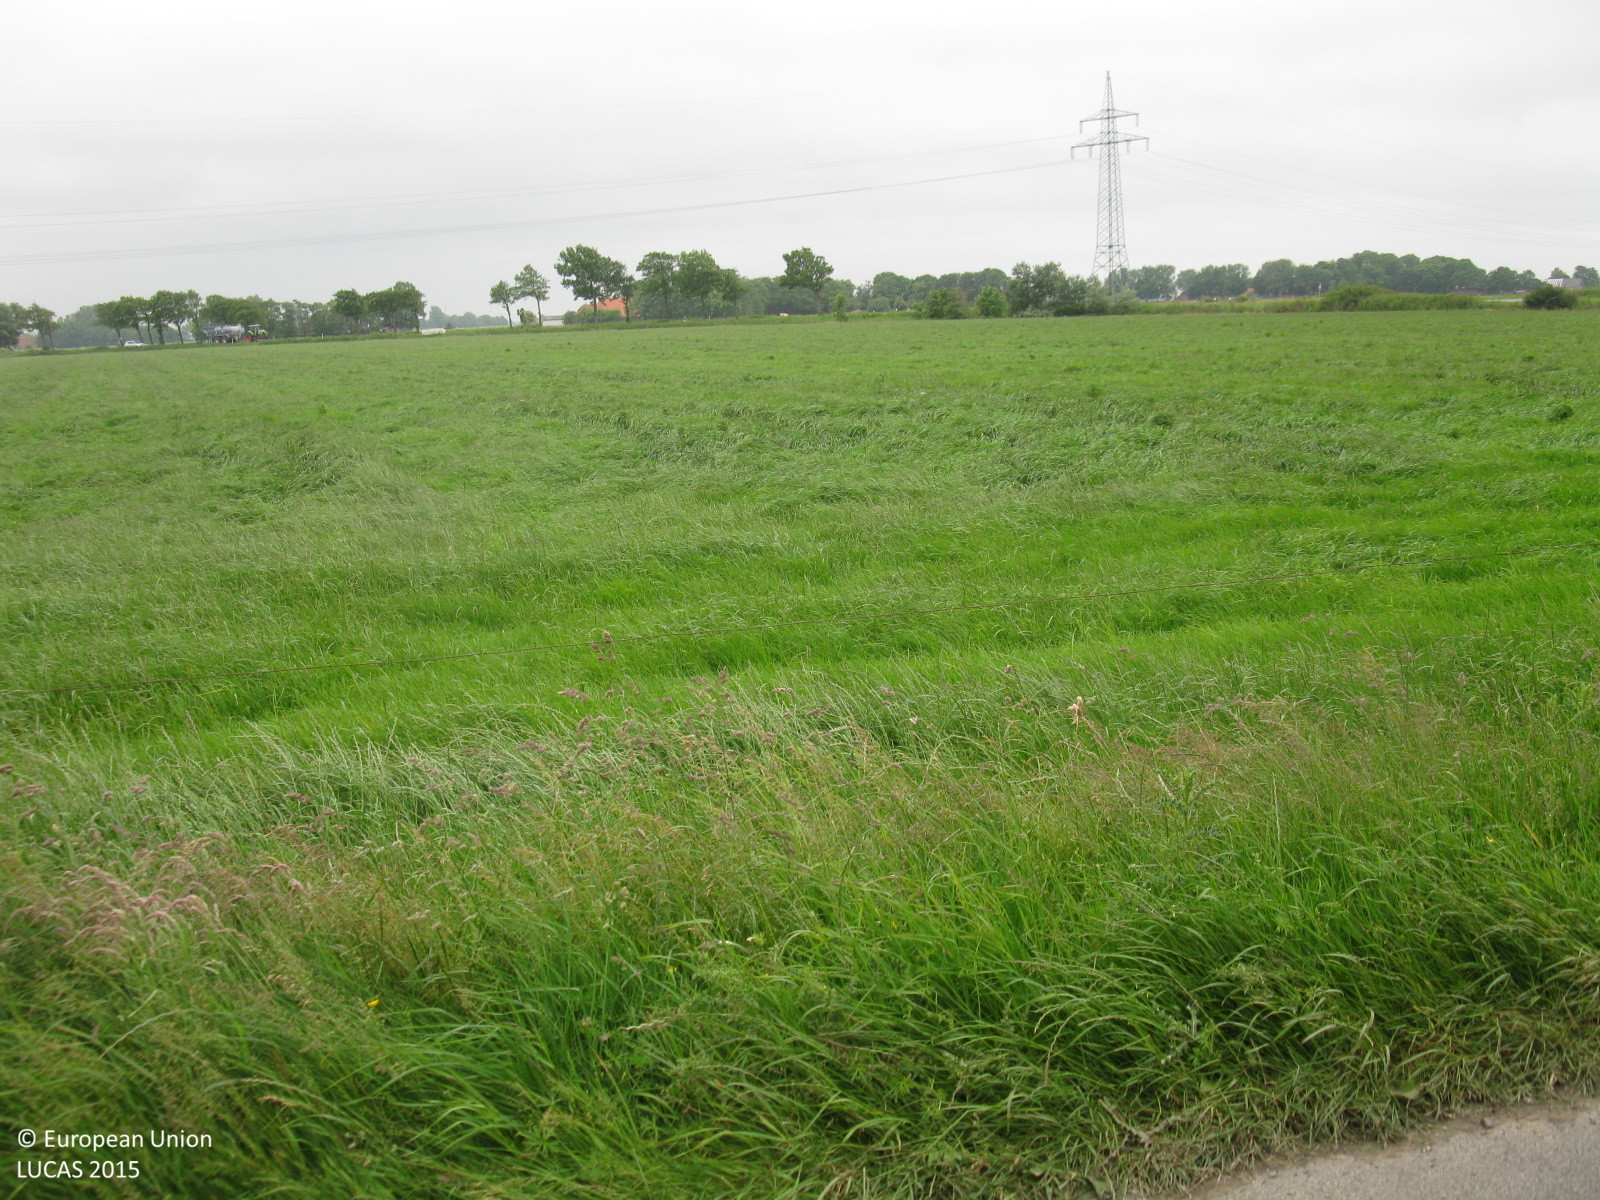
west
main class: Cropland
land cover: Rape and turnip rape
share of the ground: > 75 %
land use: Agriculture (excluding fallow land and kitchen gardens)
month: June
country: DE
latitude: 53.6708
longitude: 7.8665
